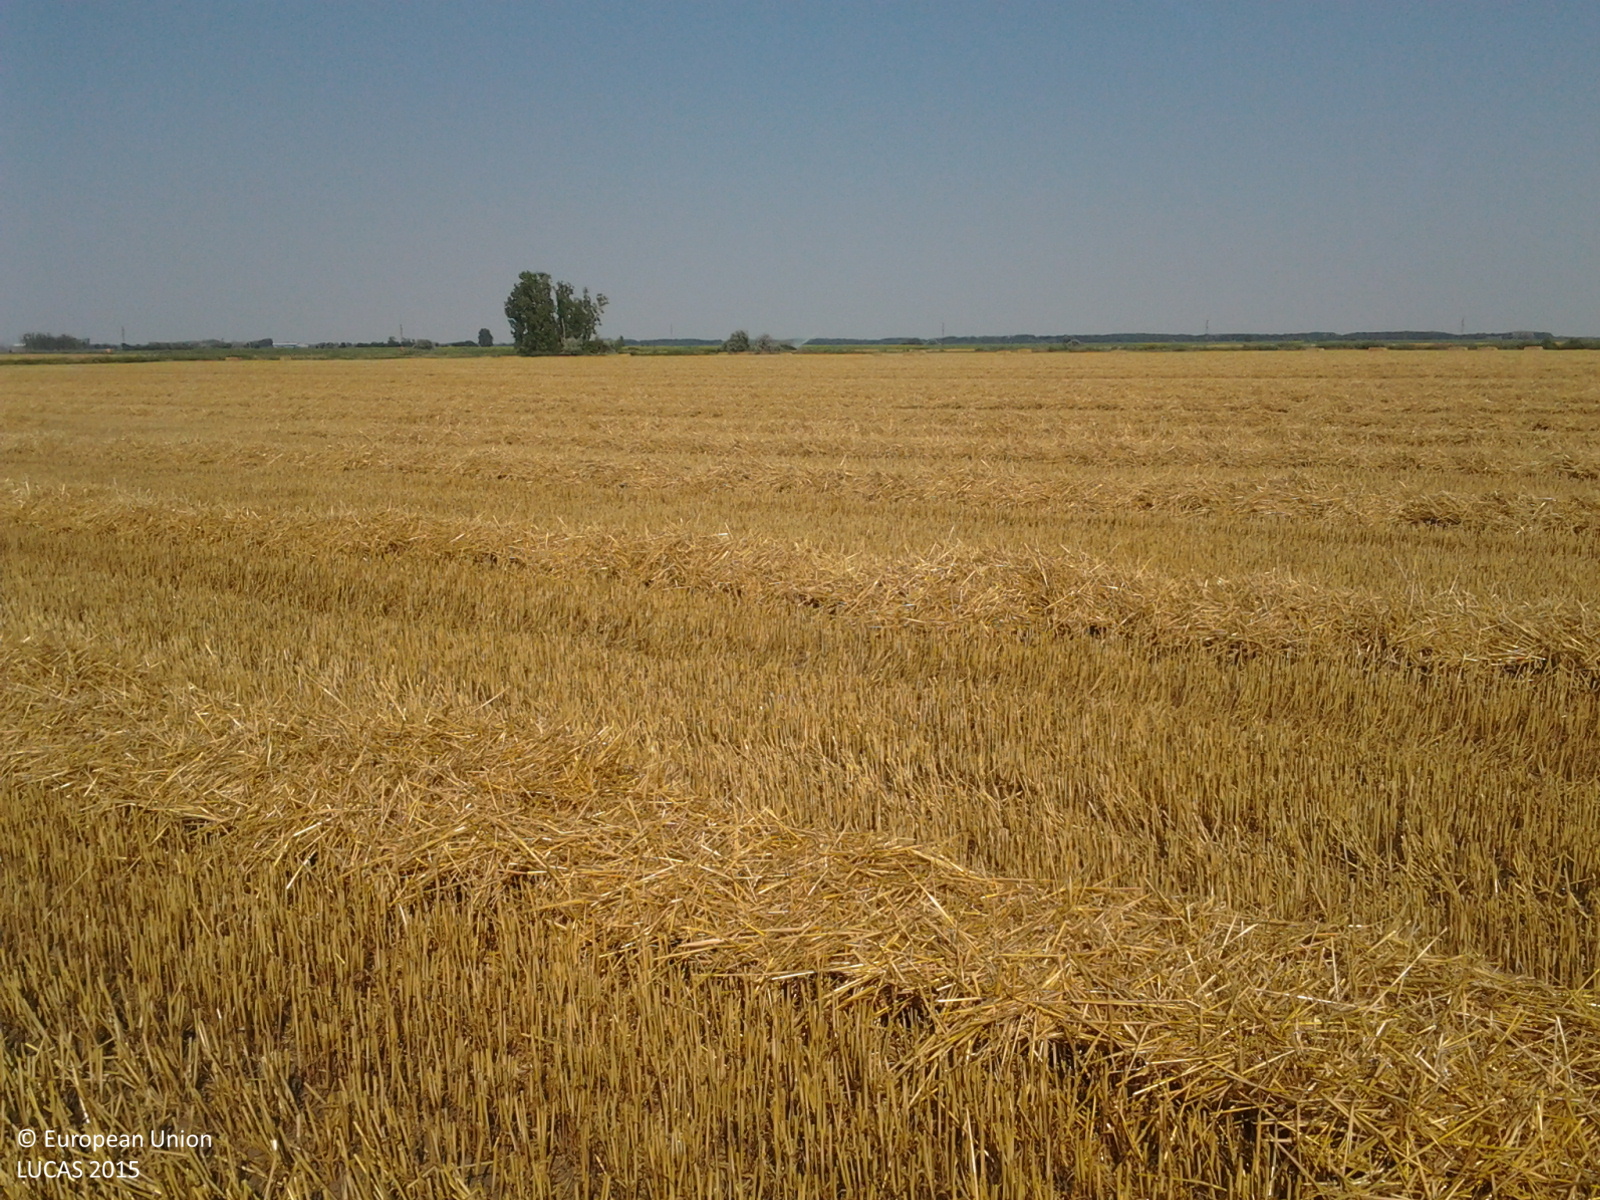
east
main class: Cropland
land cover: Triticale
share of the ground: > 75 %
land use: Agriculture (excluding fallow land and kitchen gardens)
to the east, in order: Triticale
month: July
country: HU
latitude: 47.4654
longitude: 19.9353
